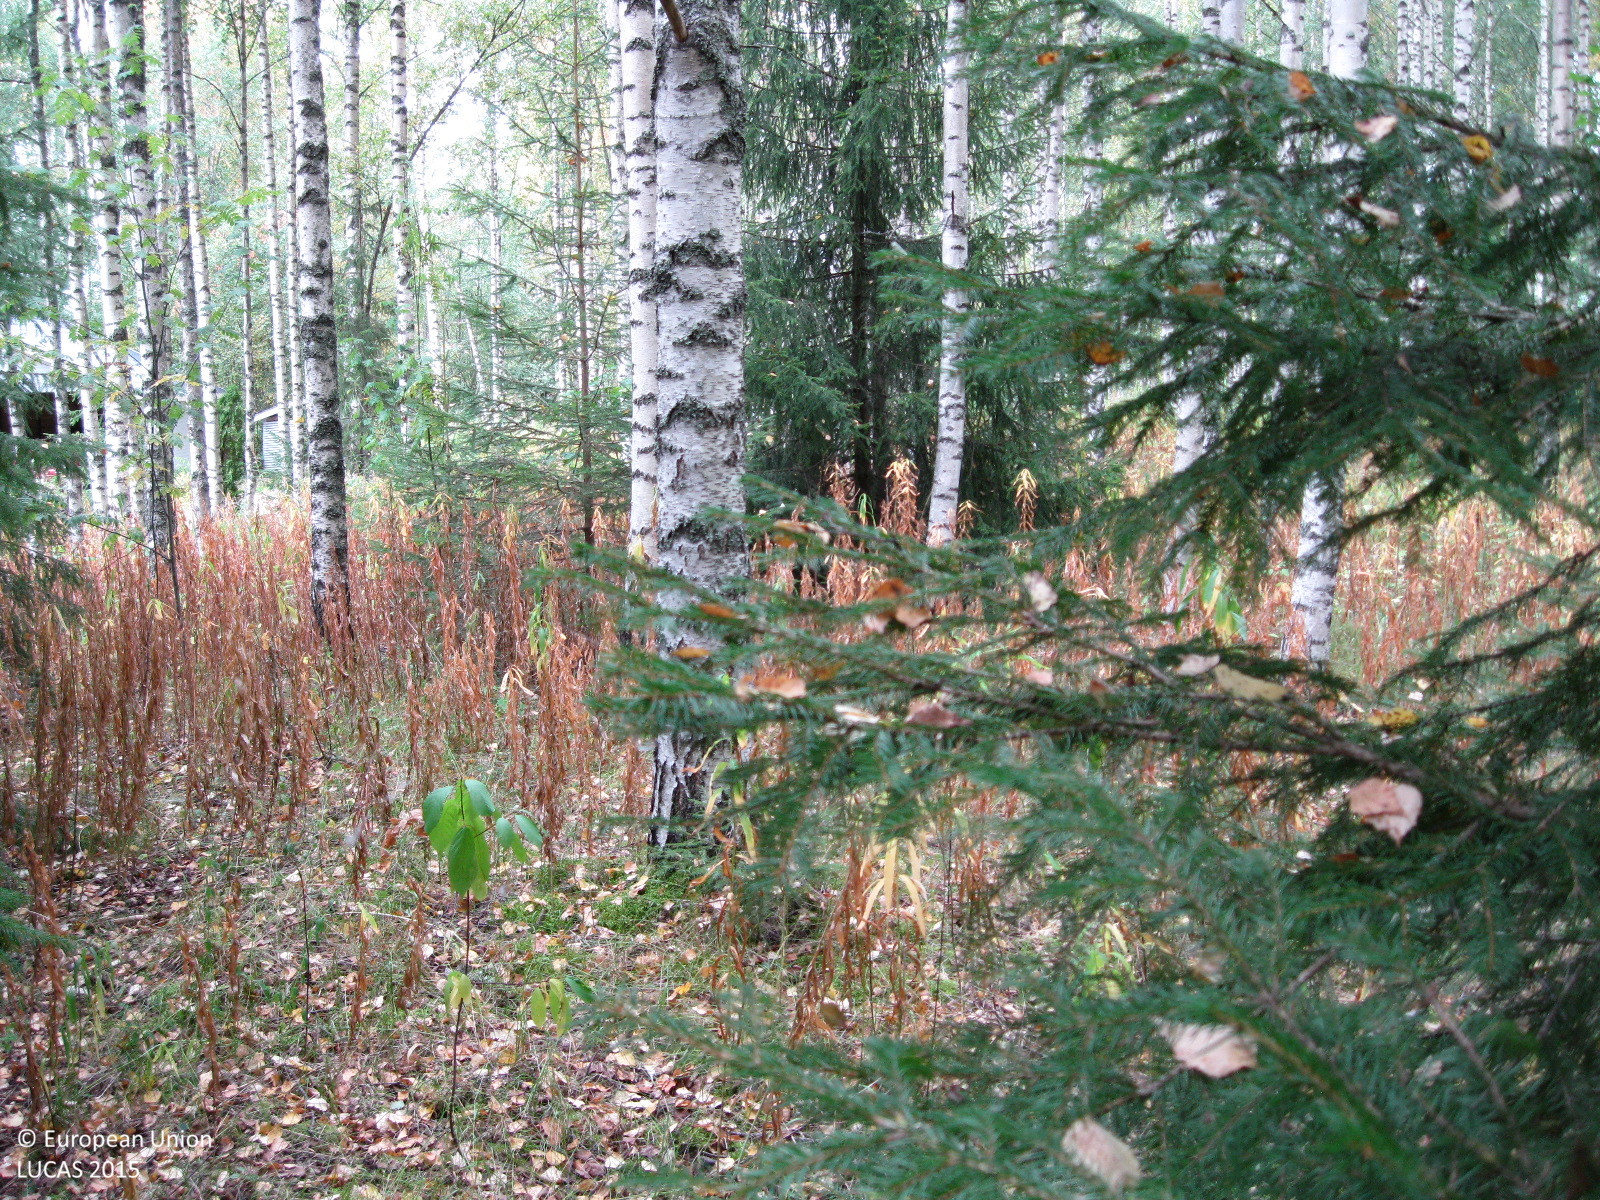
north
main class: Woodland
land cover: Broadleaved woodland
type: boreal forest
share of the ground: 50 - 75 %
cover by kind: broadleaved forest trees 55 %, herbaceous plants 25 %, coniferous forest trees 10 %, lichens and mosses 10 %
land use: Residential
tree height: > 5 m
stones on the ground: < 10 %
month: August
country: FI
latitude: 61.1597
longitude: 25.6454
